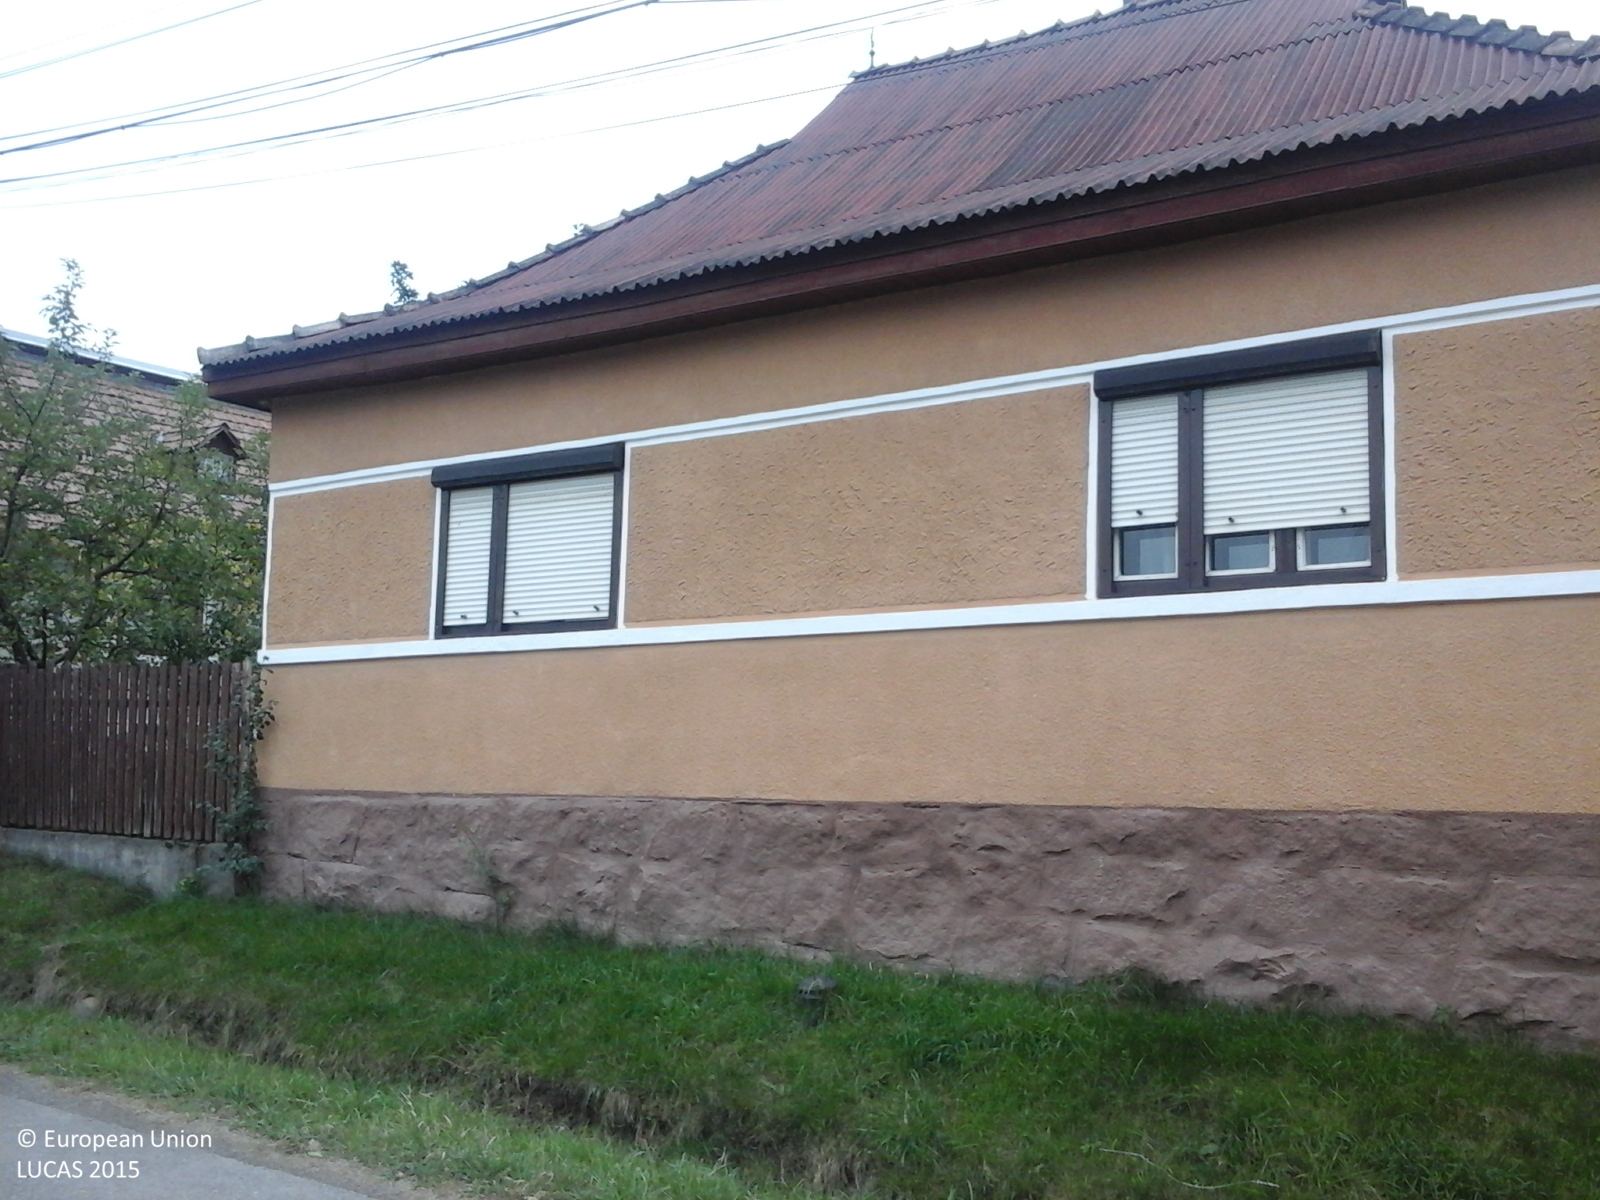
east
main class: Cropland
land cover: Apple fruit
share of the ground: > 75 %
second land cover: Grassland without tree/shrub cover
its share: > 75 %
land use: Agriculture (excluding fallow land and kitchen gardens)
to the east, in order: Fences; Artificial constructions in urban areas; Permanent crops (only in case pi); Grassland without tree/shrub cover; Fences; Grassland without tree/shrub cover; Fences; Other bare soil; Broadleaved woodland
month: October
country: RO
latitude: 46.8092
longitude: 24.9728
